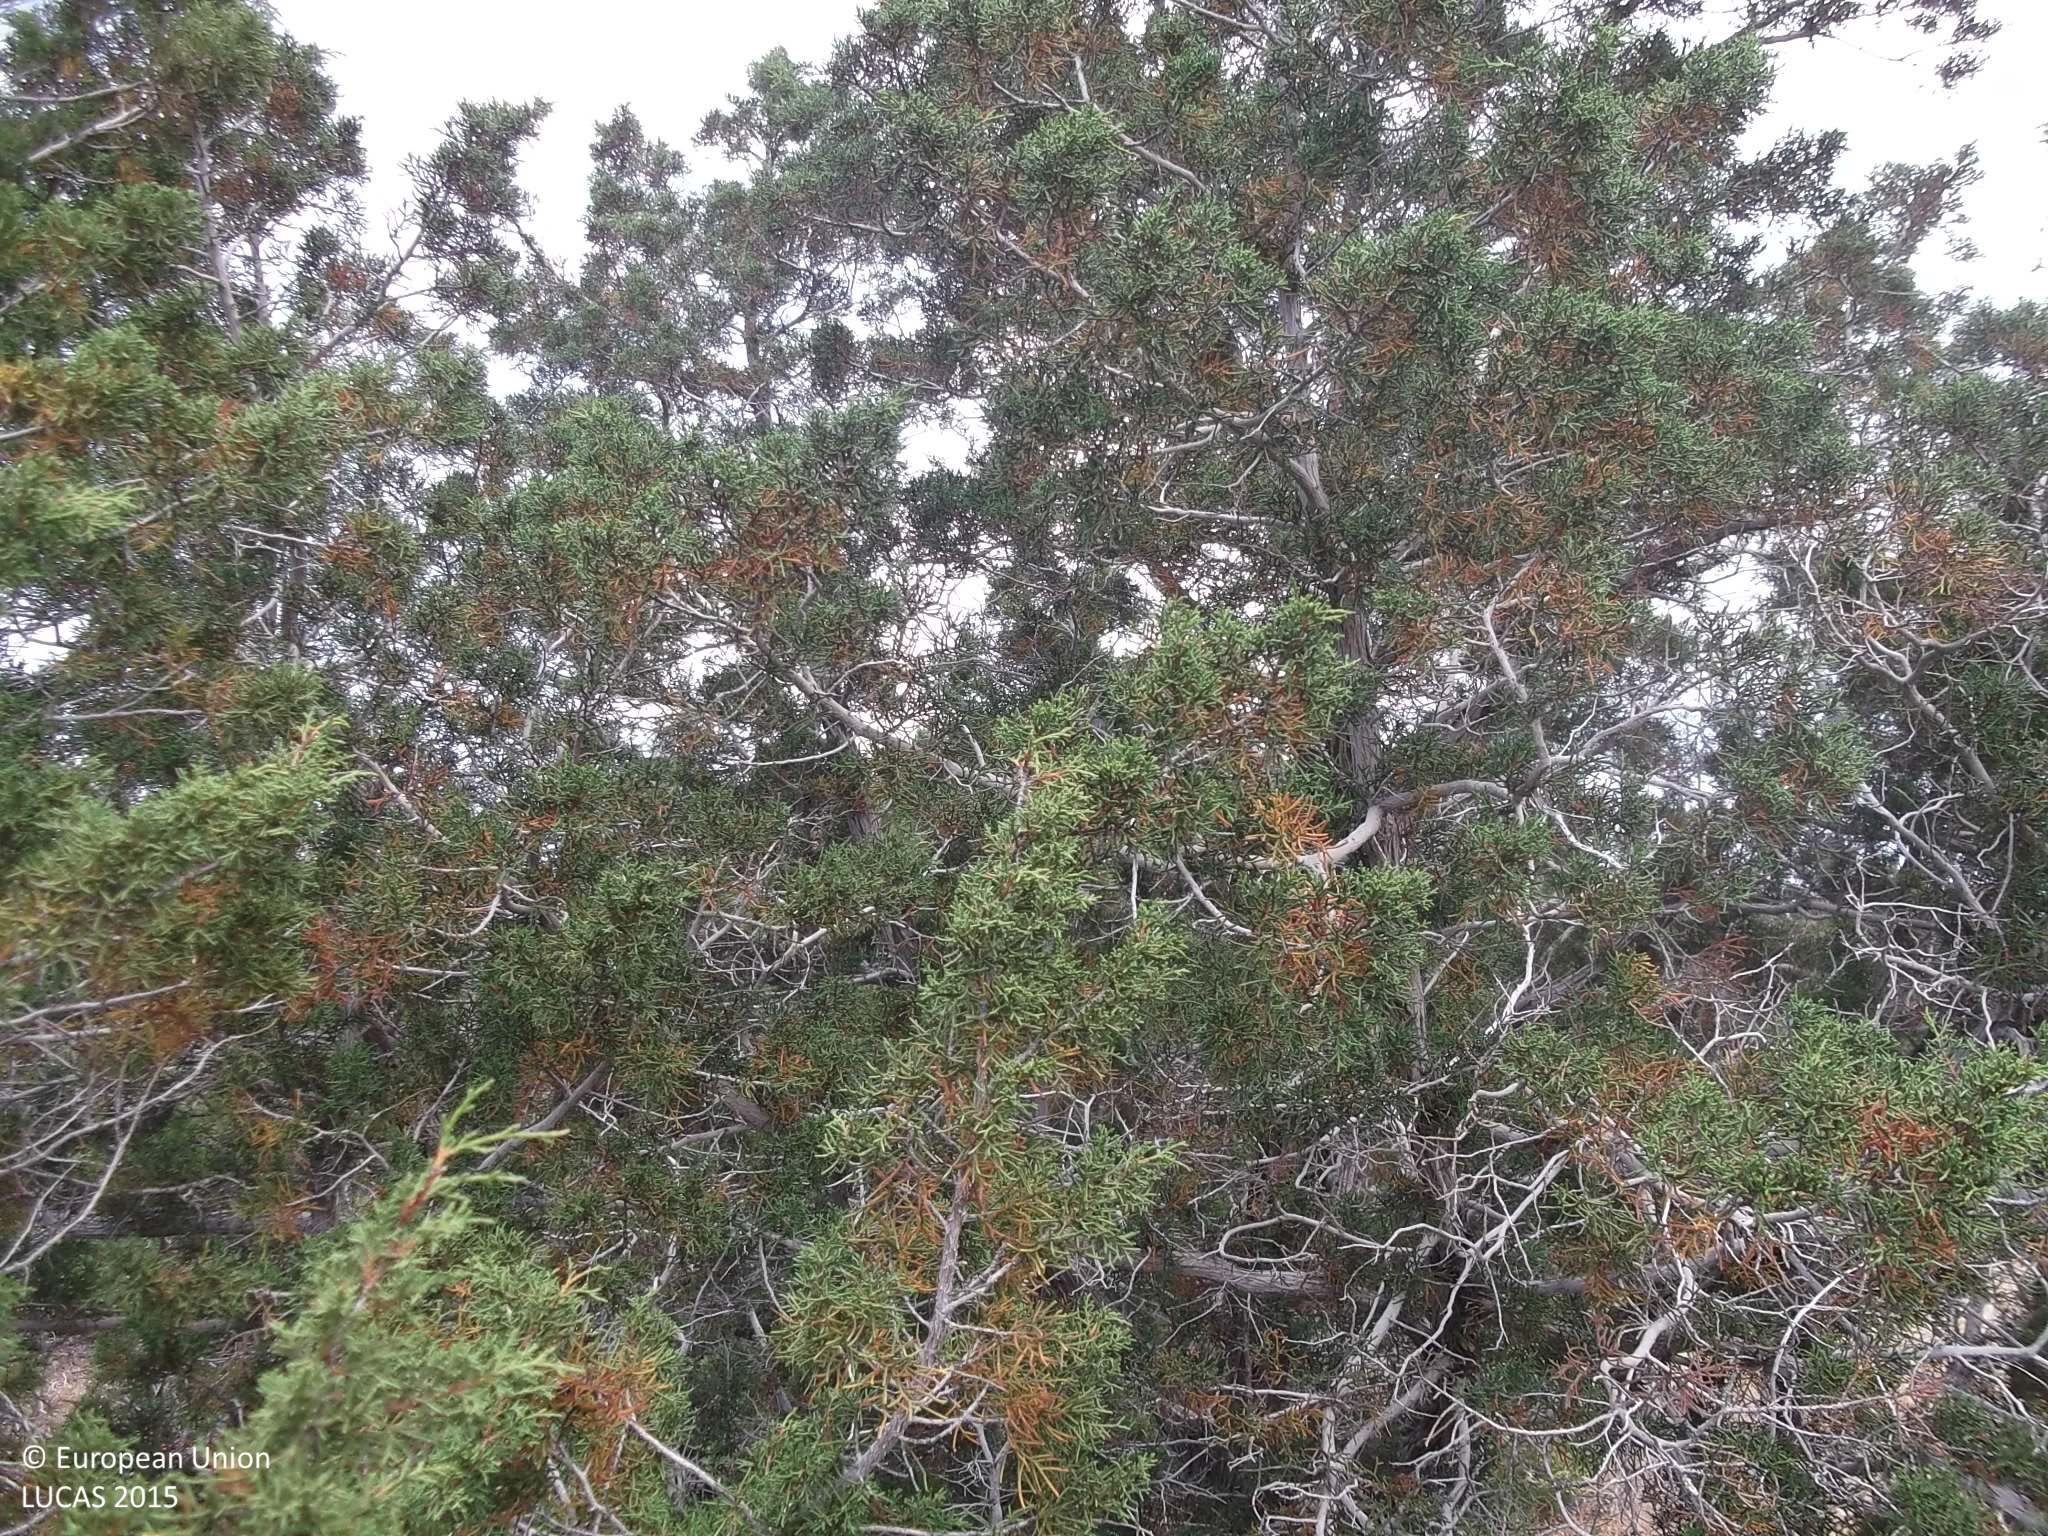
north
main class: Woodland
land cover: Other coniferous woodland
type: coniferous forest of the mediterranean region
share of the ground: > 75 %
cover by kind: coniferous forest trees 75 %, herbaceous plants 20 %, unconsolidated bare surface 5 %
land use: Agriculture (excluding fallow land and kitchen gardens)
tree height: < 5 m
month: May
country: CY
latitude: 35.0264
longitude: 32.2991
